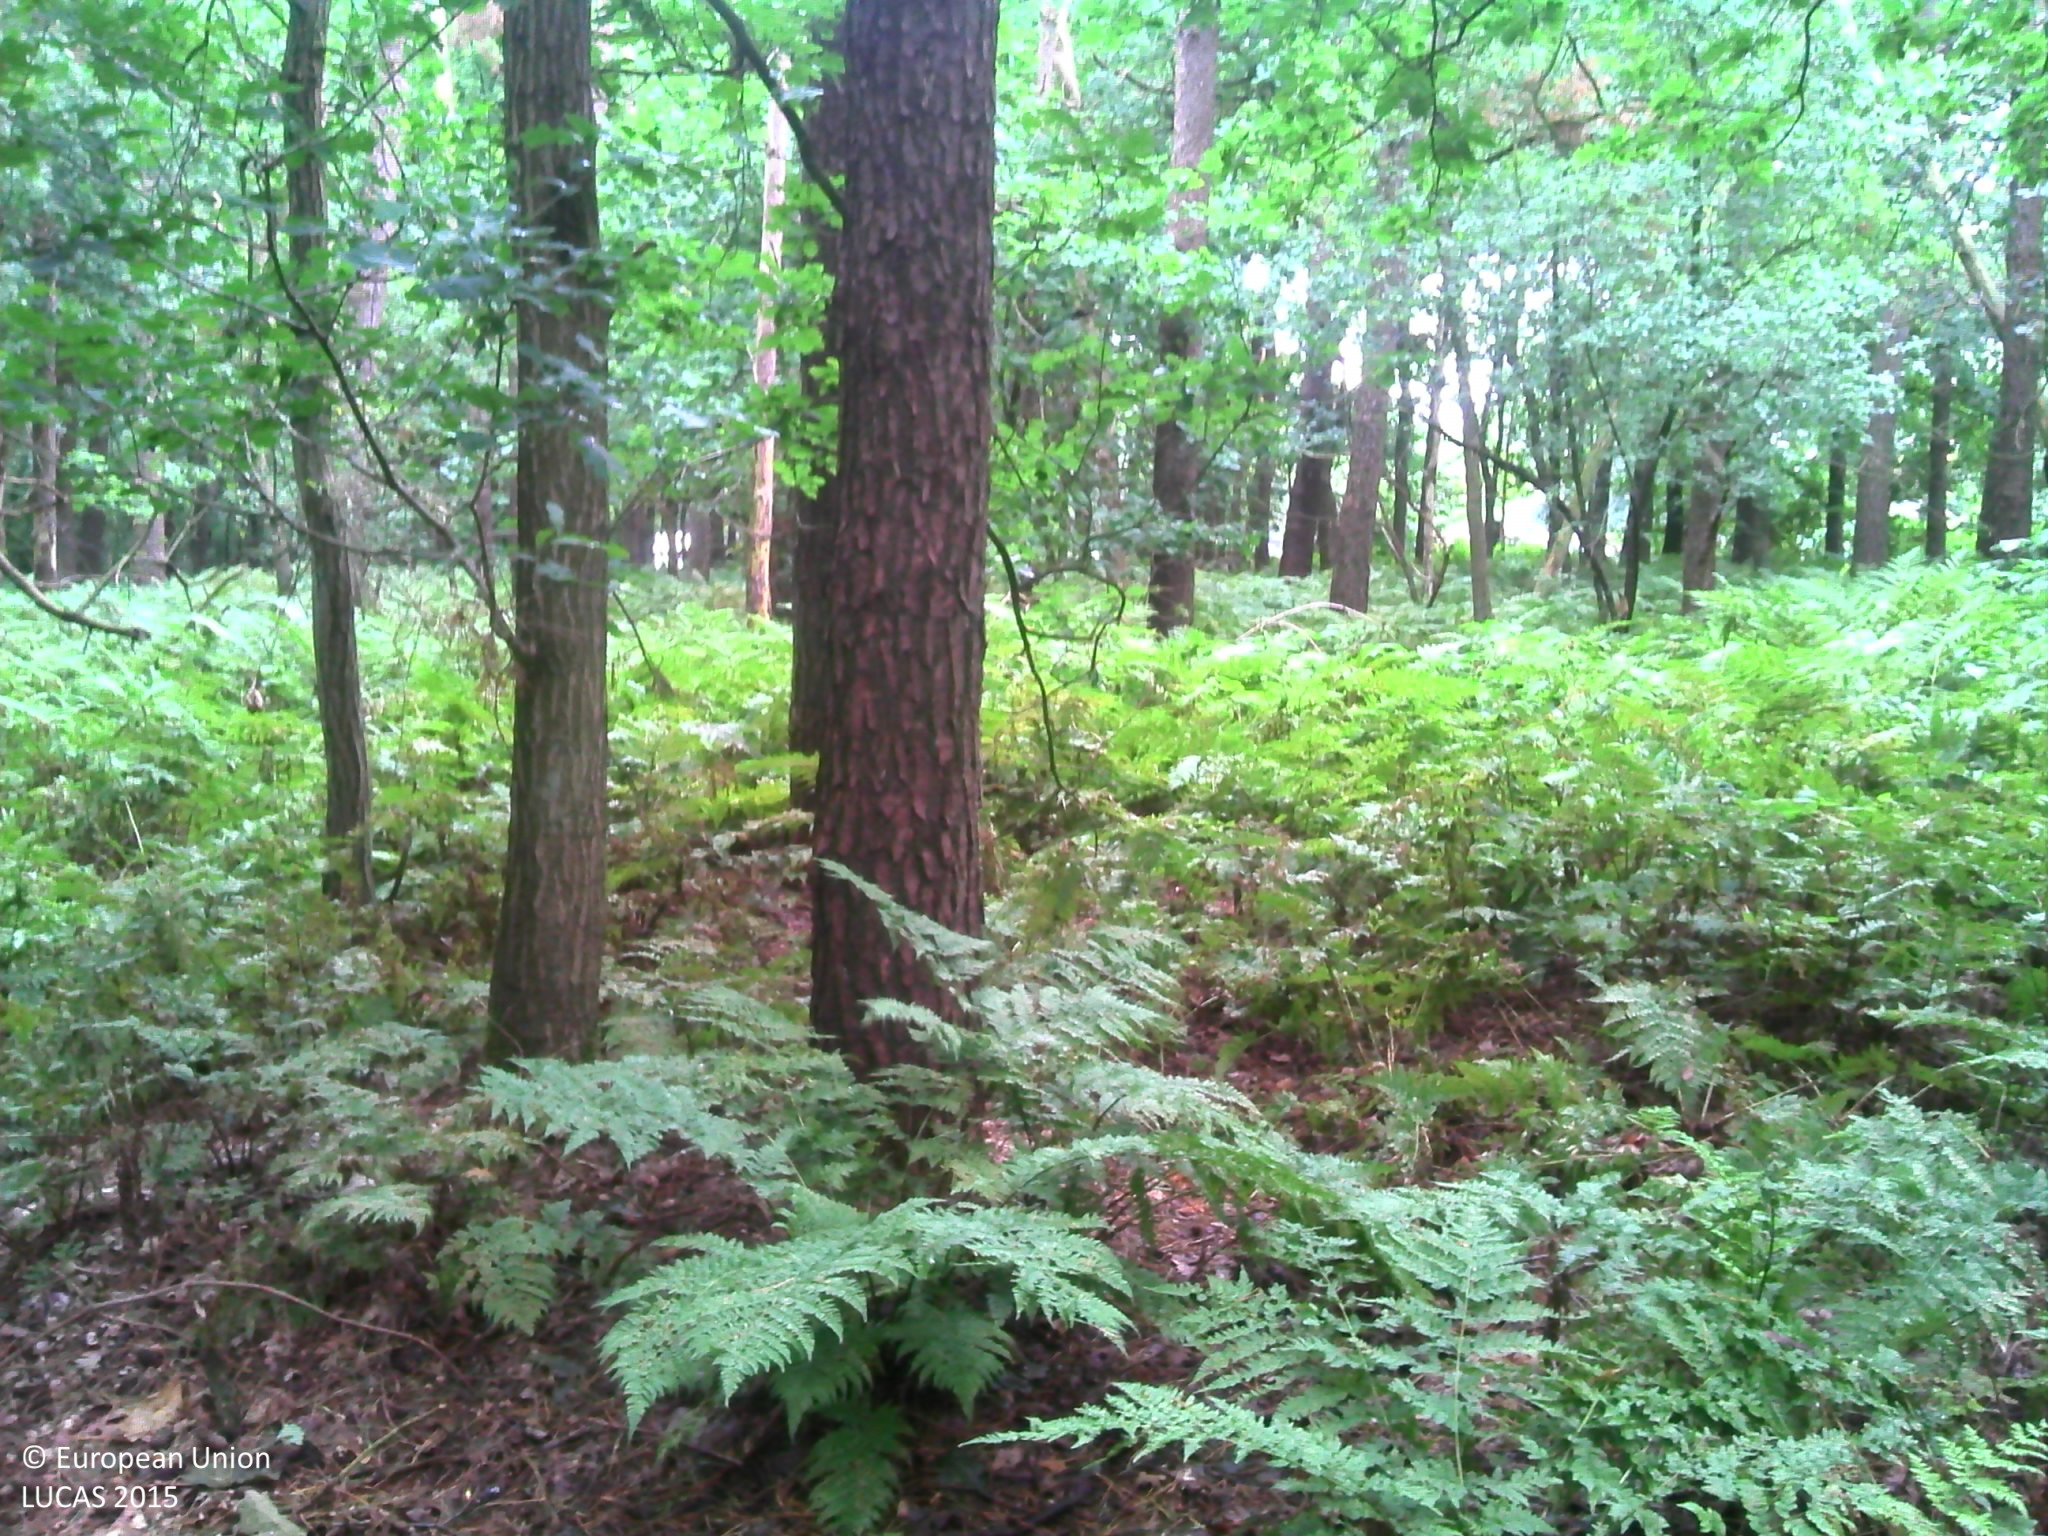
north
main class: Woodland
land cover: Pine dominated mixed woodland
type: hemiboreal forest and nemoral coniferous forest and mixed broadleaved-coniferous forest
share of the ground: > 75 %
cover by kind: coniferous forest trees 70 %, broadleaved forest trees 25 %, herbaceous plants 5 %
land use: Forestry
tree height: > 5 m
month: August
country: BE
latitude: 51.3889
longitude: 4.9818
